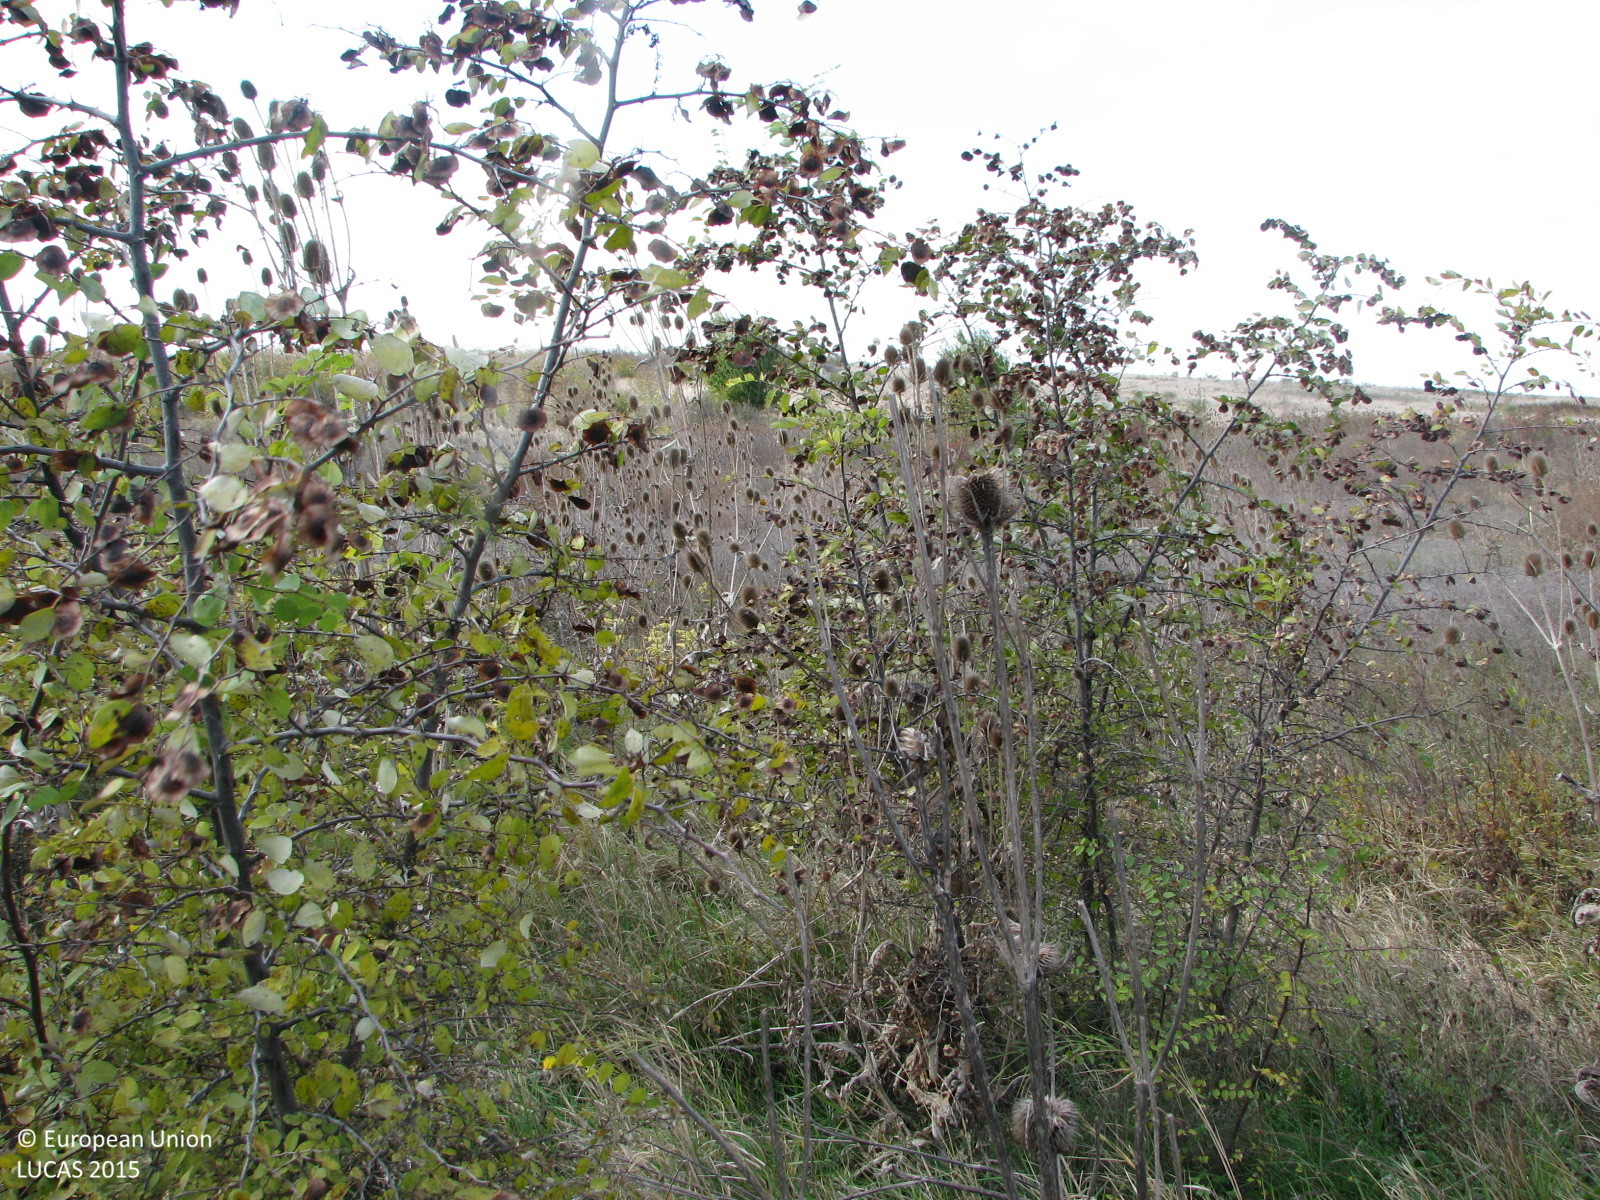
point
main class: Shrubland
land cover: Shrubland without tree cover
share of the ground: 50 - 75 %
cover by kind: shrubs 70 %, herbaceous plants 30 %
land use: Semi-natural and natural areas not in use
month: November
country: BG
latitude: 42.4778
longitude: 26.8757
